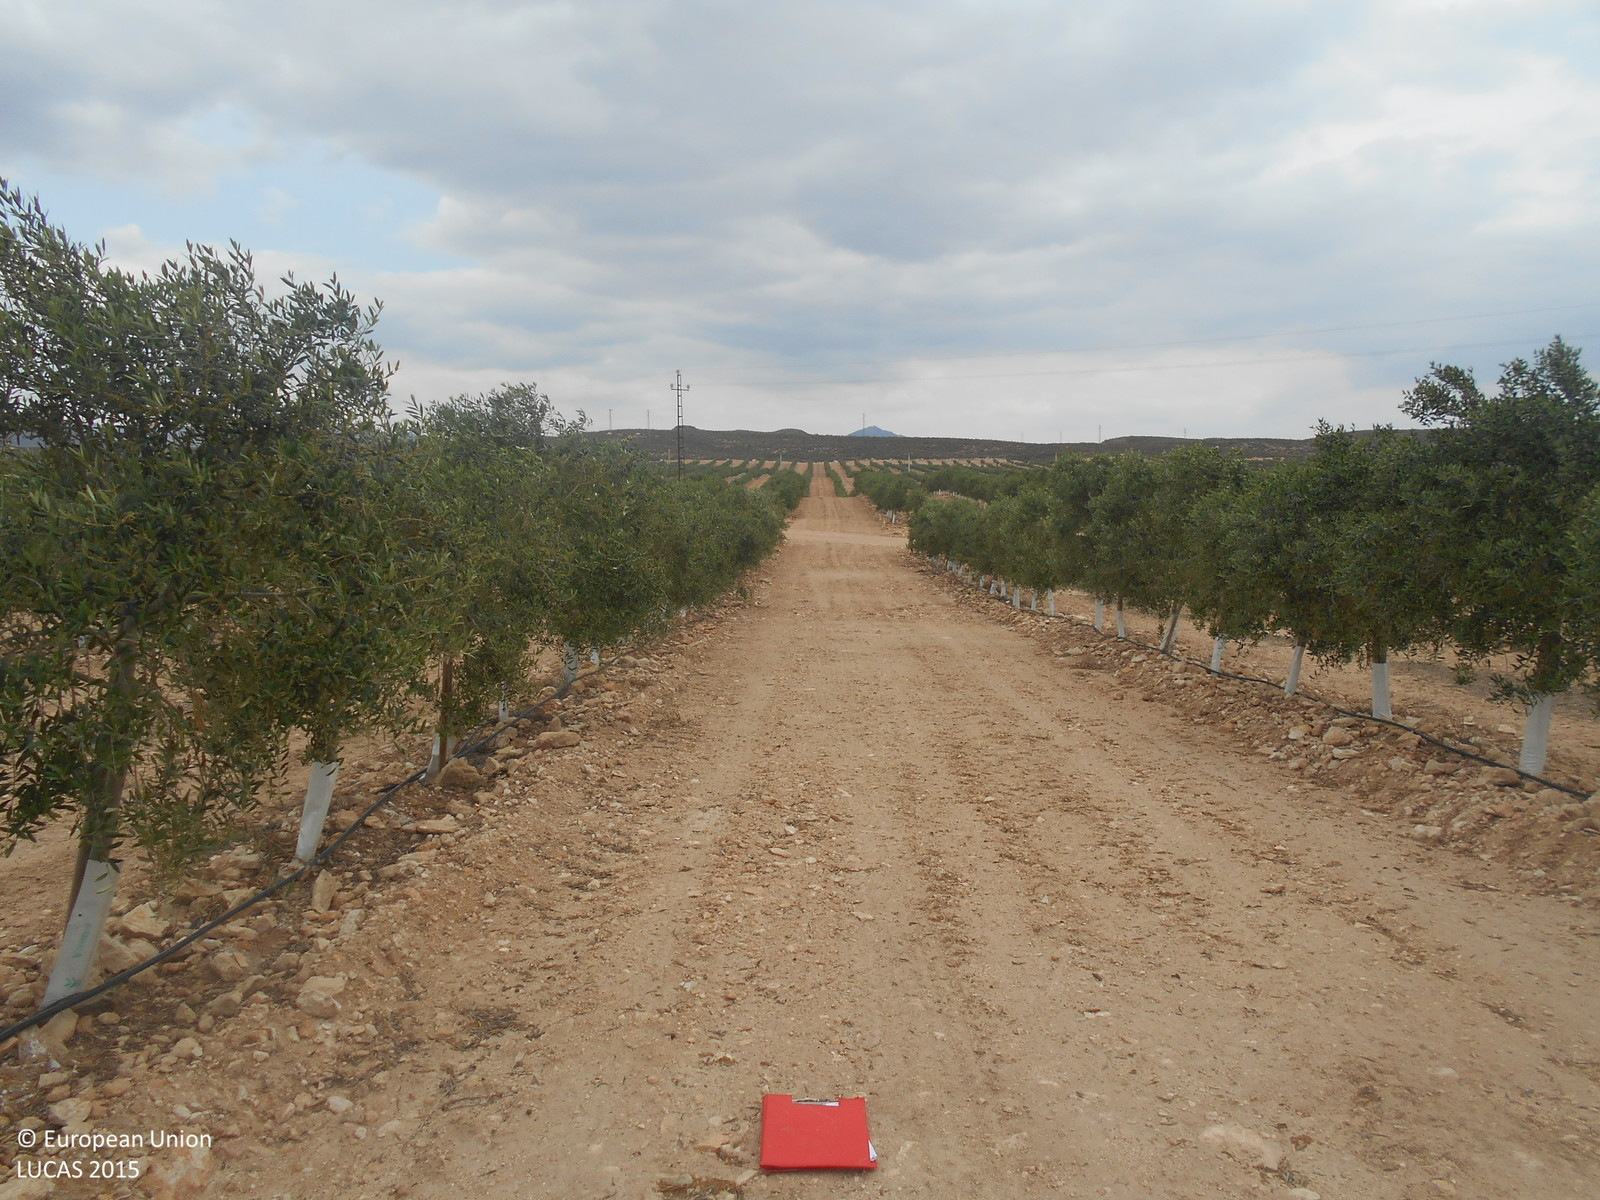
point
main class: Cropland
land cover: Olive groves
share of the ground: 10 - 25 %
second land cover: Other bare soil
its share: > 75 %
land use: Agriculture (excluding fallow land and kitchen gardens)
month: May
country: ES
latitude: 37.0985
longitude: -2.2532
